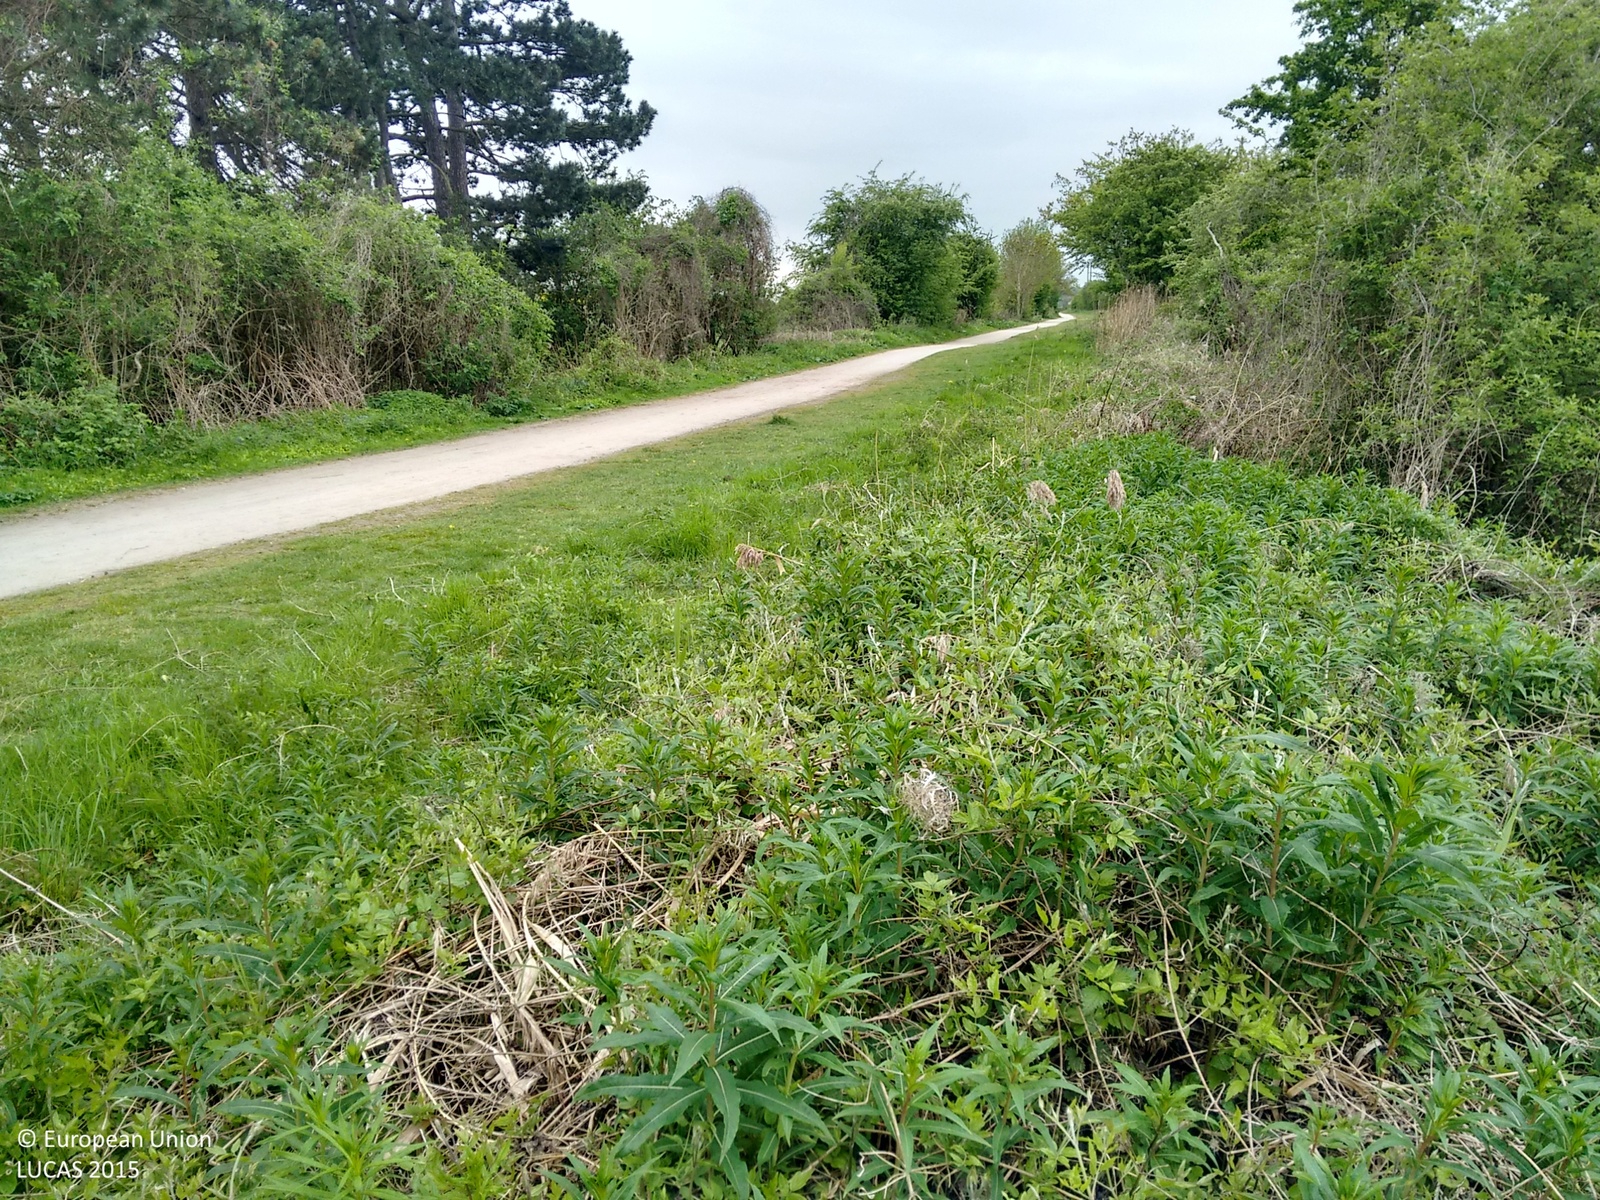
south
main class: Grassland
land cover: Grassland without tree/shrub cover
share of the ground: > 75 %
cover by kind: herbaceous plants 100 %
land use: Agriculture (excluding fallow land and kitchen gardens)
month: May
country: GB
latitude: 52.1744
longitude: -1.7381
